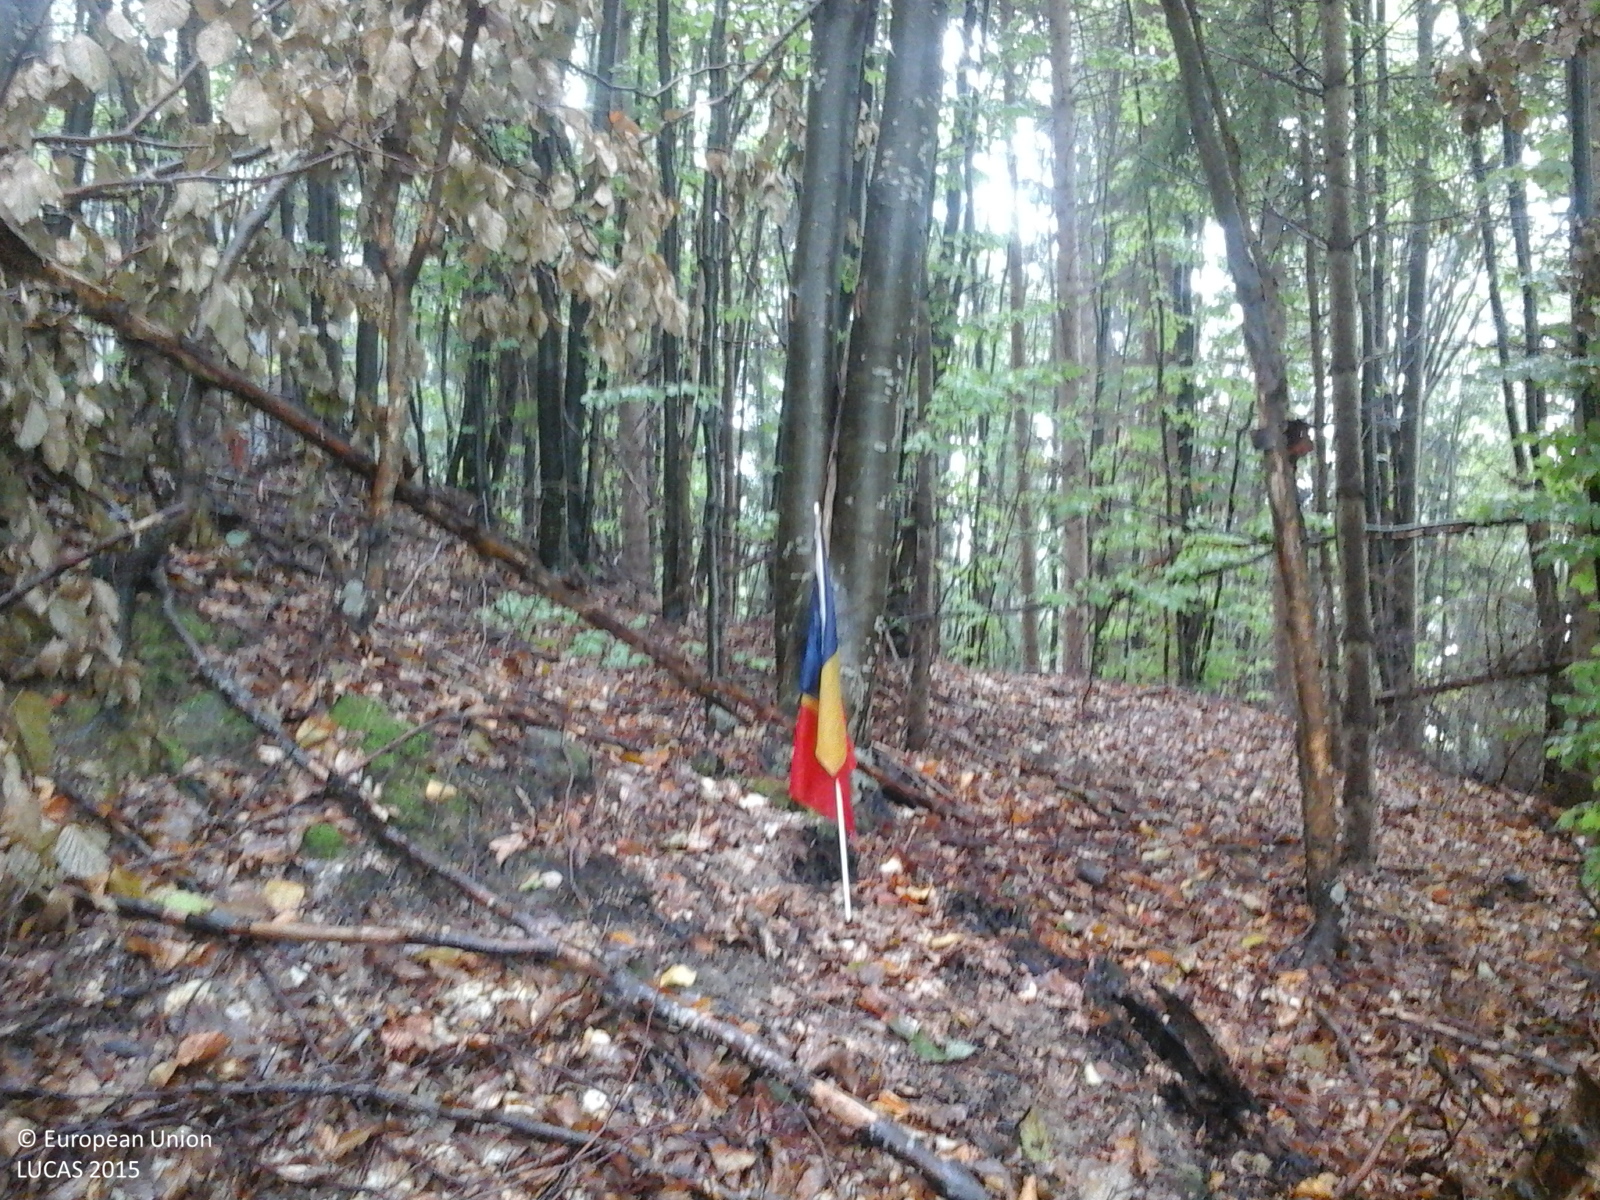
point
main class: Woodland
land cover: Other mixed woodland
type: mountainous beech forest
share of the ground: > 75 %
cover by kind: broadleaved forest trees 75 %, coniferous forest trees 25 %
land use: Forestry
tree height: > 5 m
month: September
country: RO
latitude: 47.5940
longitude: 24.0350
